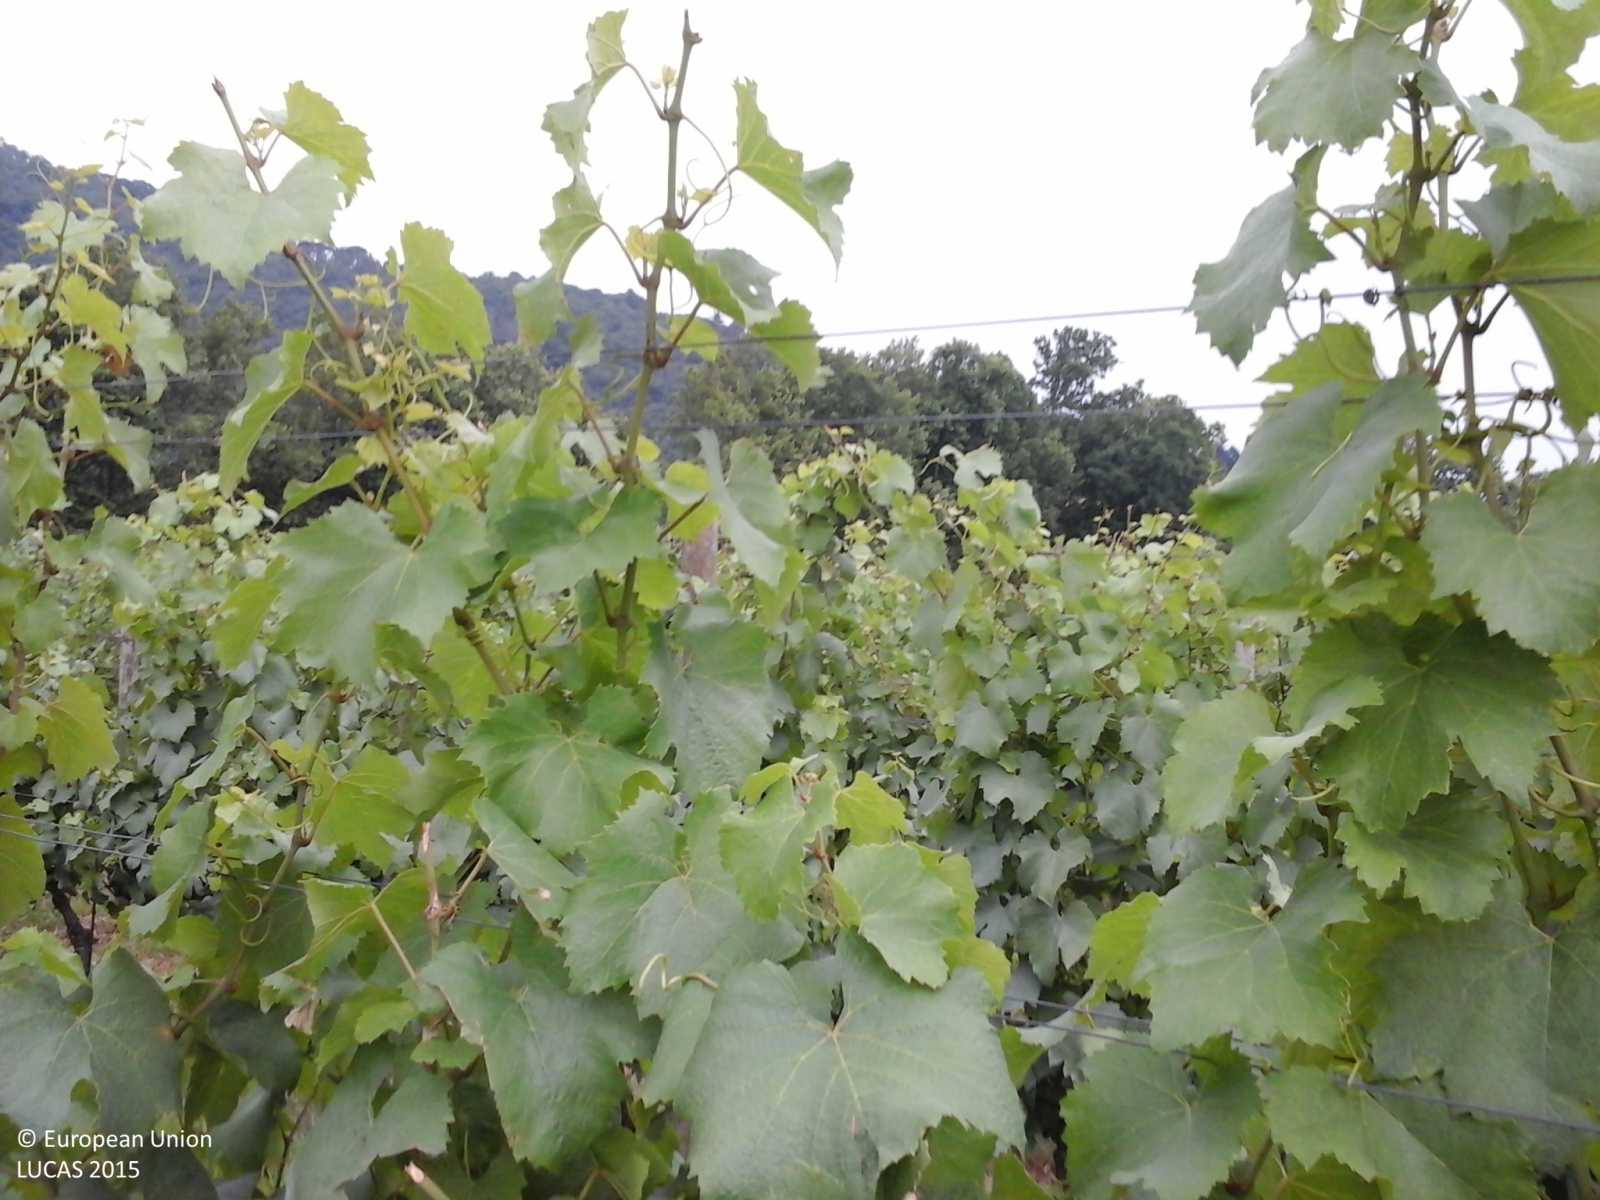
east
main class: Cropland
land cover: Vineyards
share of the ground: 10 - 25 %
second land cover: Spontaneously vegetated surfaces
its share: > 75 %
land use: Agriculture (excluding fallow land and kitchen gardens)
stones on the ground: 10 - 25 %
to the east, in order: Vineyards; Spontaneously vegetated surfaces; Tracks; Grass margins; Maize; Grass margins; Other structural elements; Lines of trees; Paved roads, cycling and walking lanes; Spontaneously vegetated surfaces; Maize
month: June
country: IT
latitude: 45.5765
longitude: 9.9616
